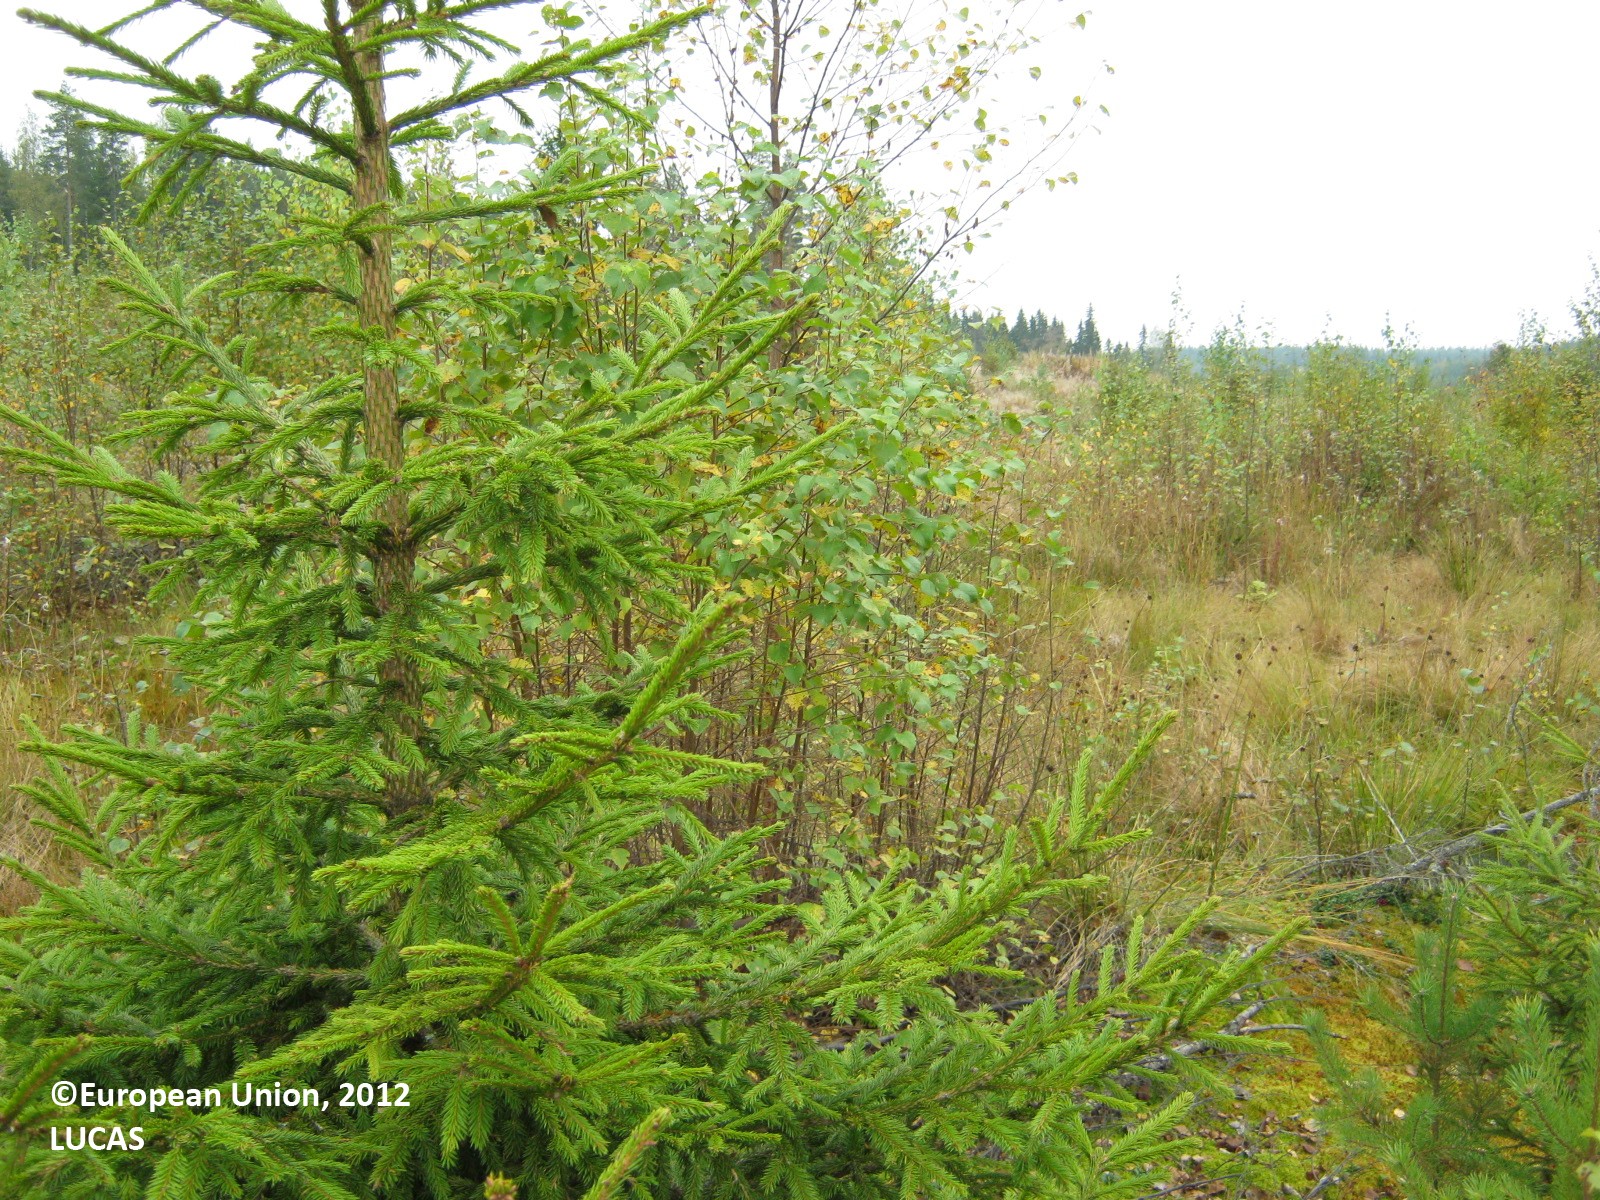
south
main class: Woodland
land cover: Broadleaved woodland
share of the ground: > 75 %
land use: Forestry
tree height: < 5 m
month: September
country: FI
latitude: 61.0228
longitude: 27.9039
